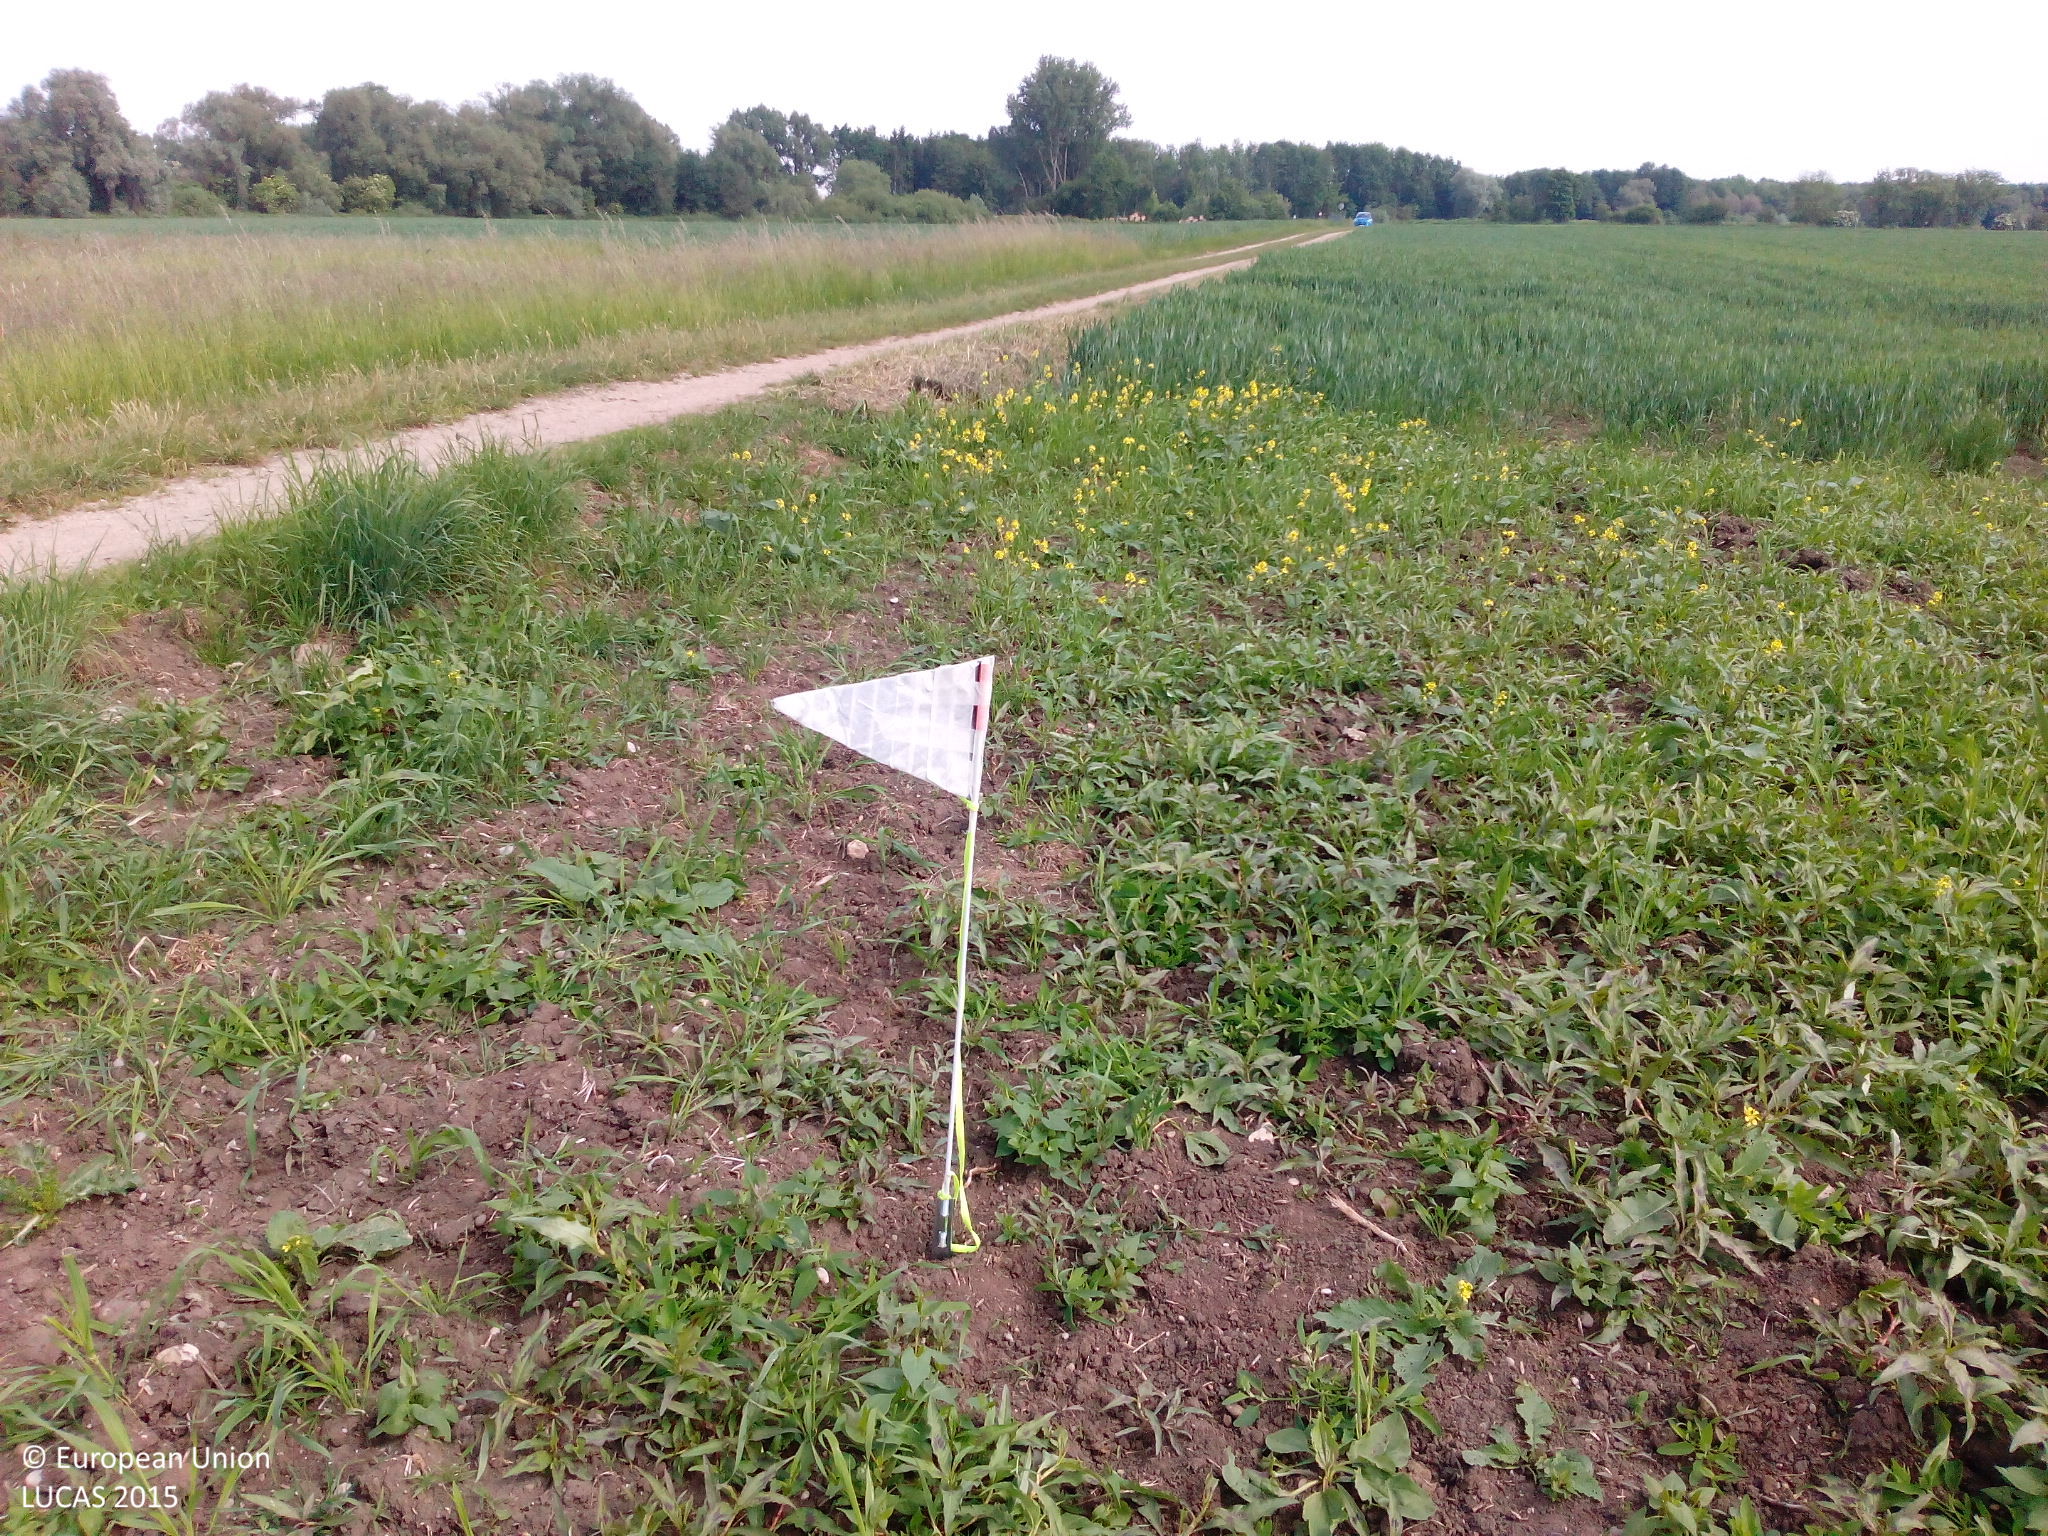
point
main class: Grassland
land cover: Spontaneously vegetated surfaces
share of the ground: 25 - 50 %
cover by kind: unconsolidated bare surface 60 %, herbaceous plants 40 %
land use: Agriculture (excluding fallow land and kitchen gardens)
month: May
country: DE
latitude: 48.6995
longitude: 11.4803
